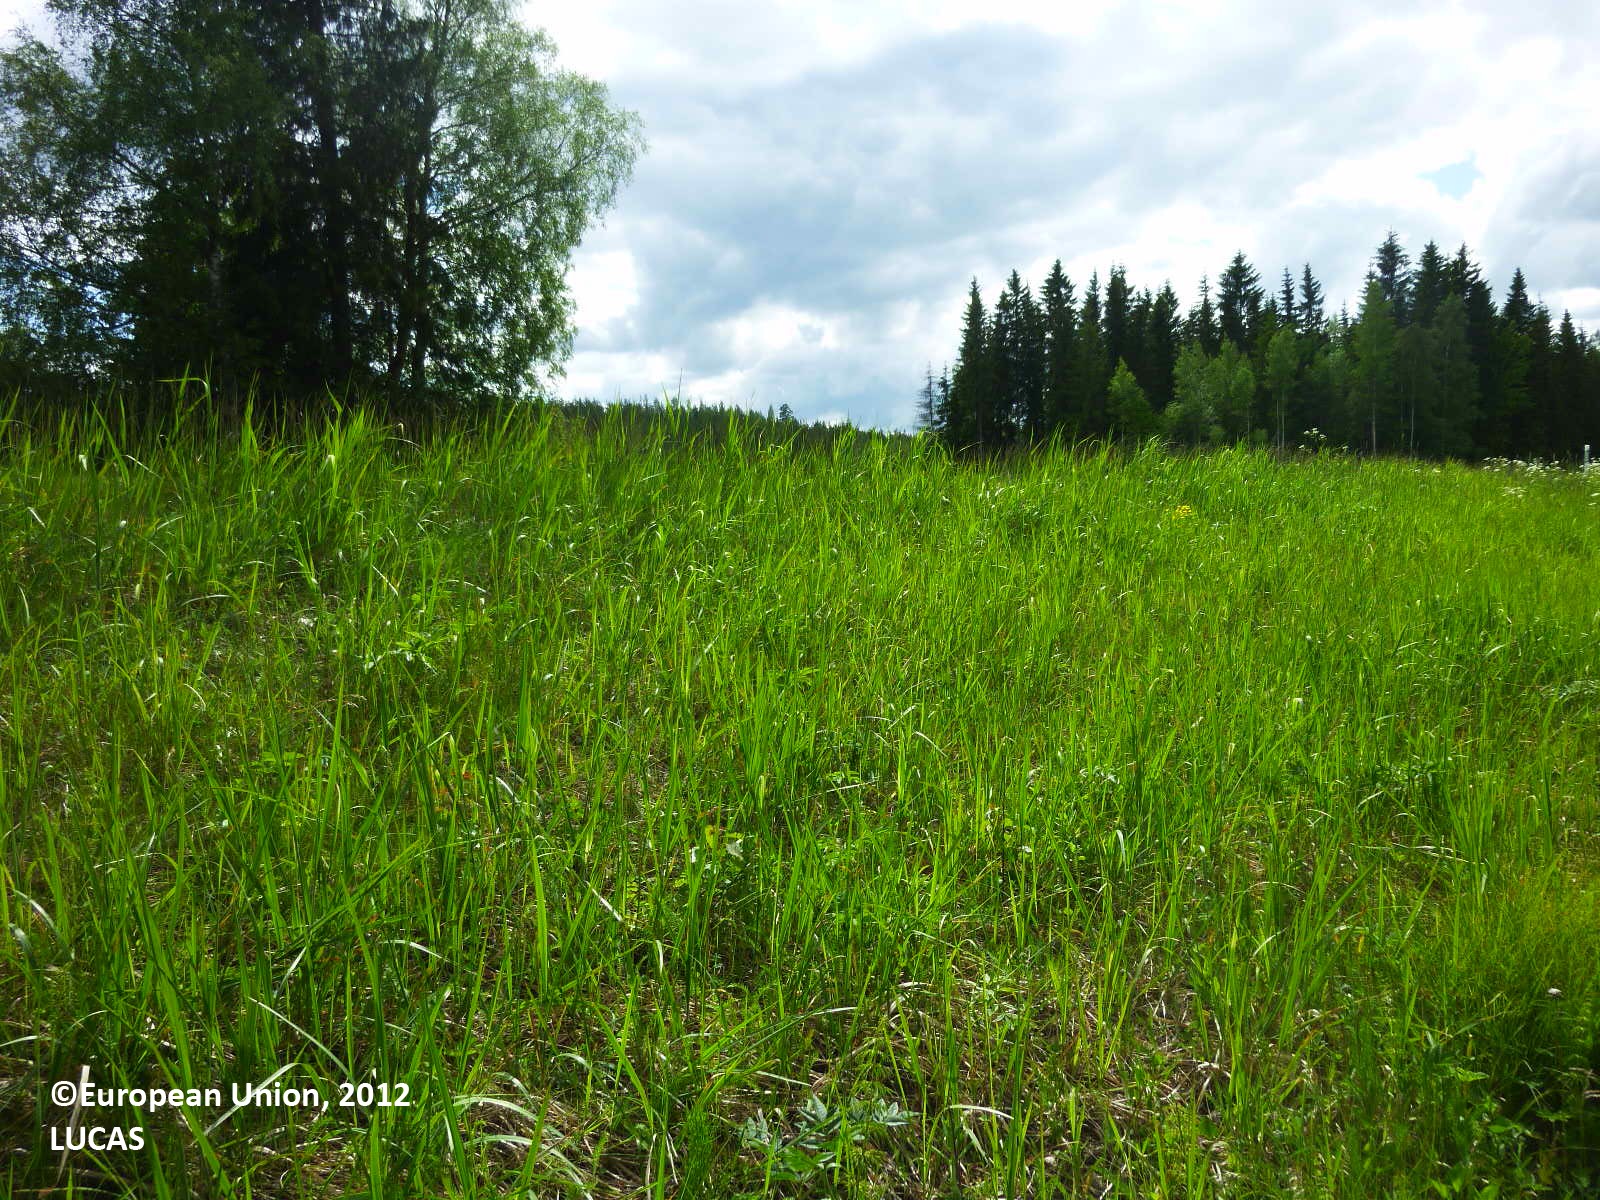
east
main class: Grassland
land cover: Grassland without tree/shrub cover
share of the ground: > 75 %
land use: Road transport
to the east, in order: Grassland without tree/shrub cover; Paved roads, cycling and walking lanes; Grassland without tree/shrub cover; Spruce dominated mixed woodland; Shrubland with sparse tree cover; Rivers and streams; Spruce dominated mixed woodland; Shrubland without tree cover; Grassland without tree/shrub cover
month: June
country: FI
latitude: 61.4780
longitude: 22.5868
